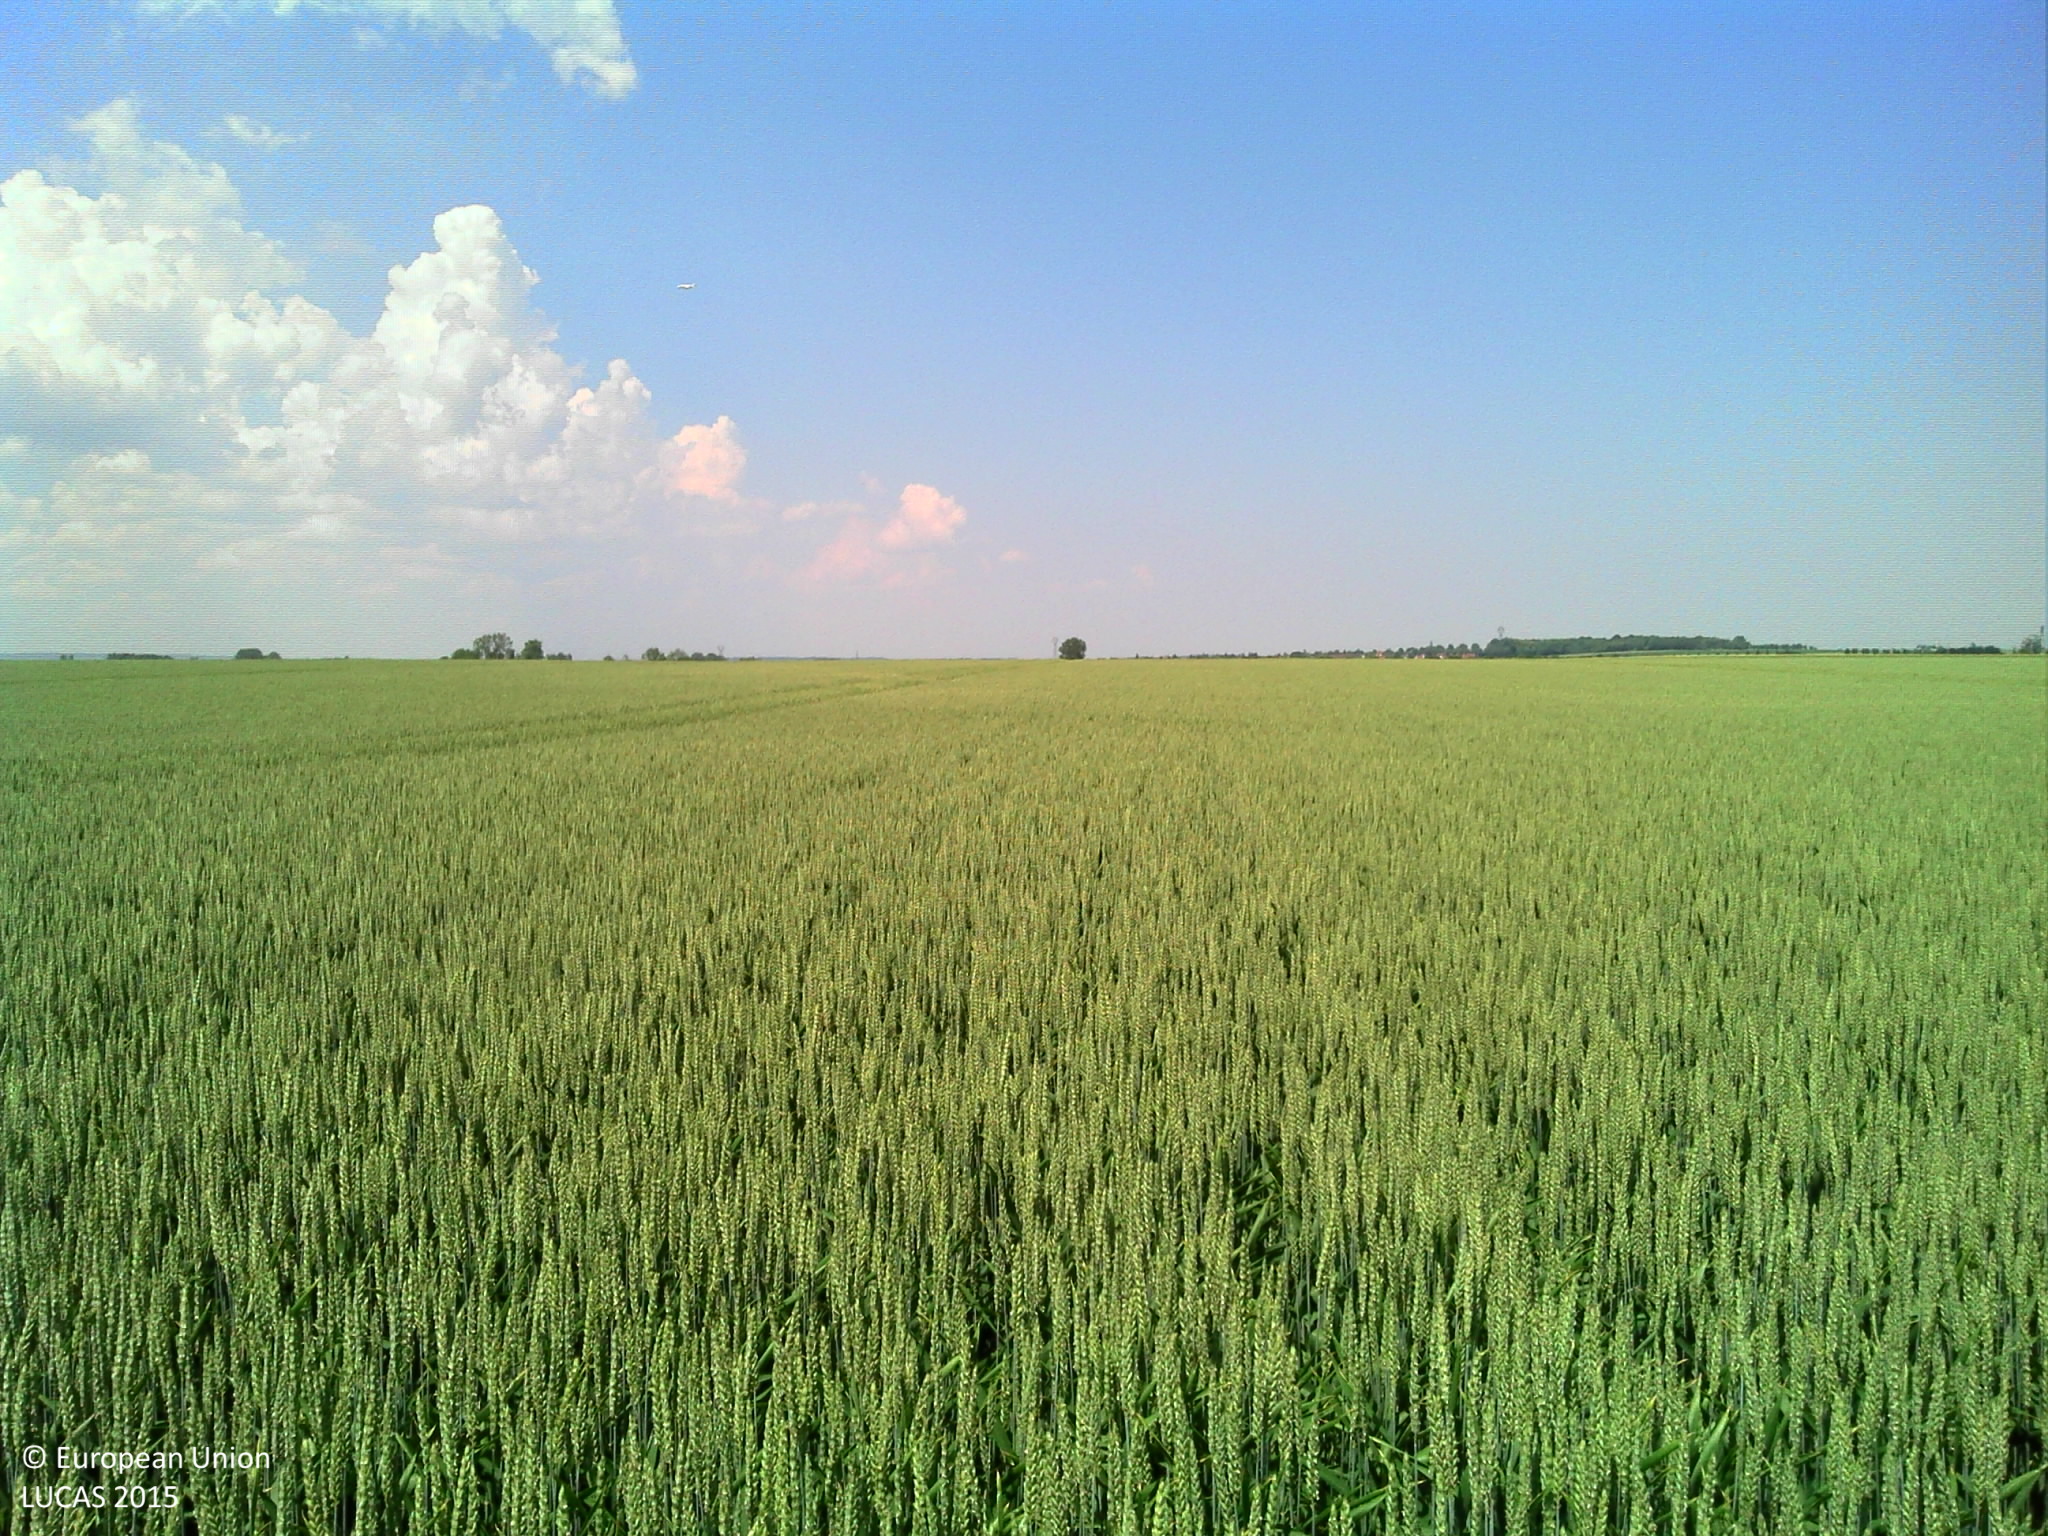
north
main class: Cropland
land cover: Common wheat
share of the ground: > 75 %
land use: Agriculture (excluding fallow land and kitchen gardens)
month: June
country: FR
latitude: 47.3221
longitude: 5.1185
